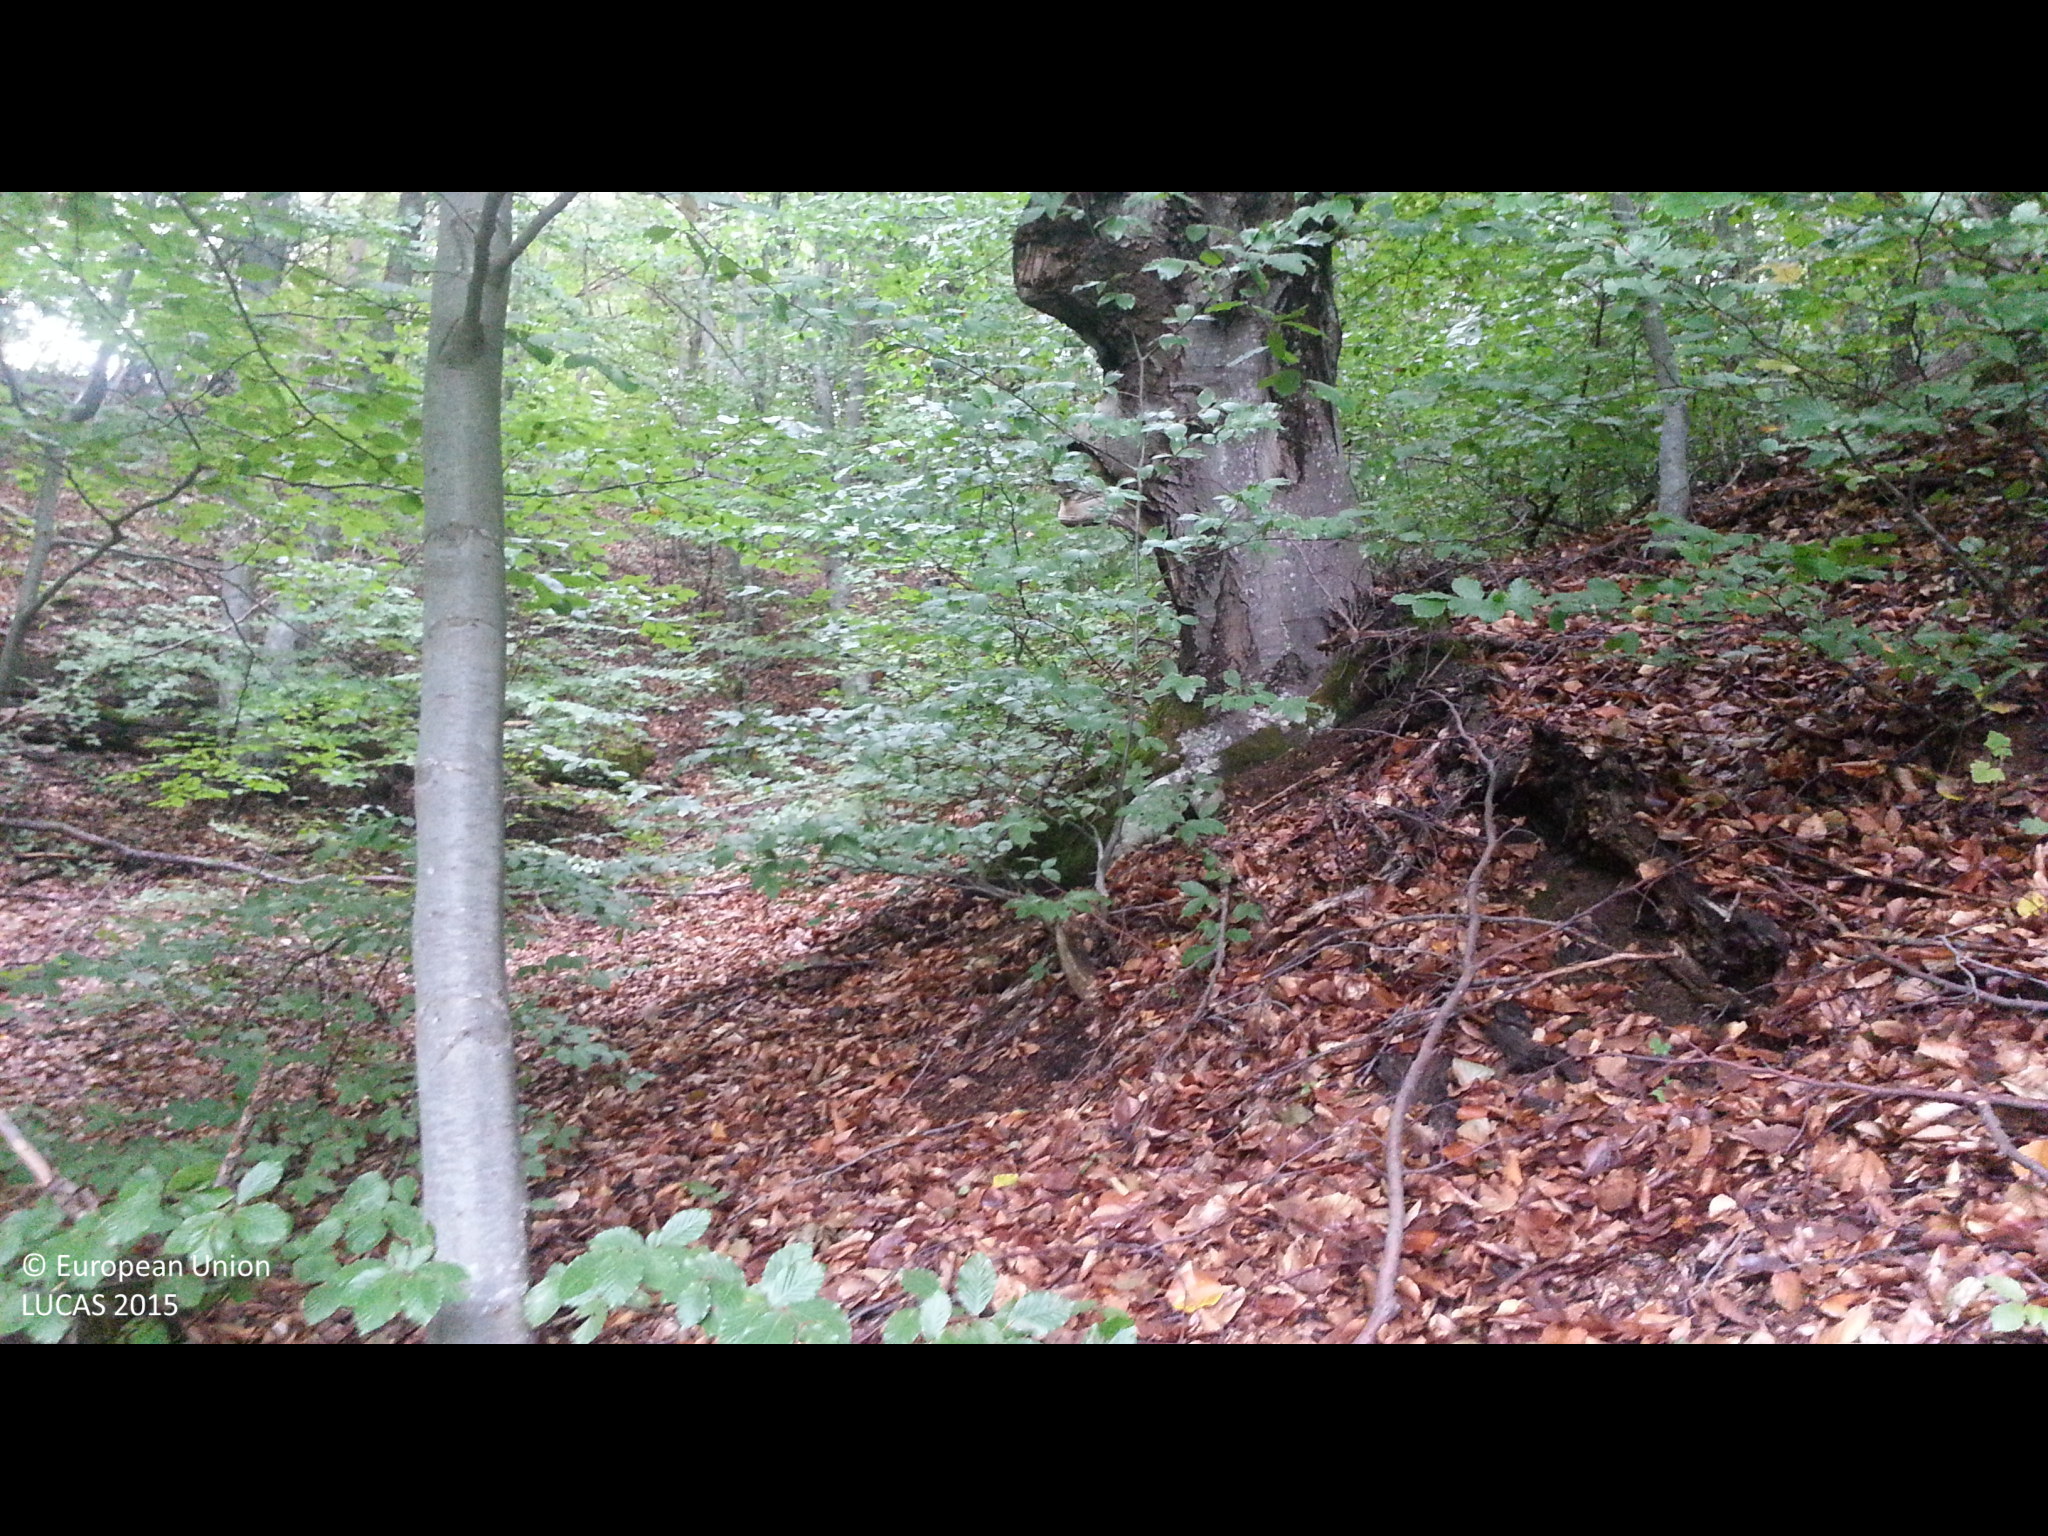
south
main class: Woodland
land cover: Broadleaved woodland
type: mountainous beech forest
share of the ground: > 75 %
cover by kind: broadleaved forest trees 95 %, shrubs 5 %
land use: Forestry
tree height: > 5 m
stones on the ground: < 10 %
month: September
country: BG
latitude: 42.3998
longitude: 22.5468
